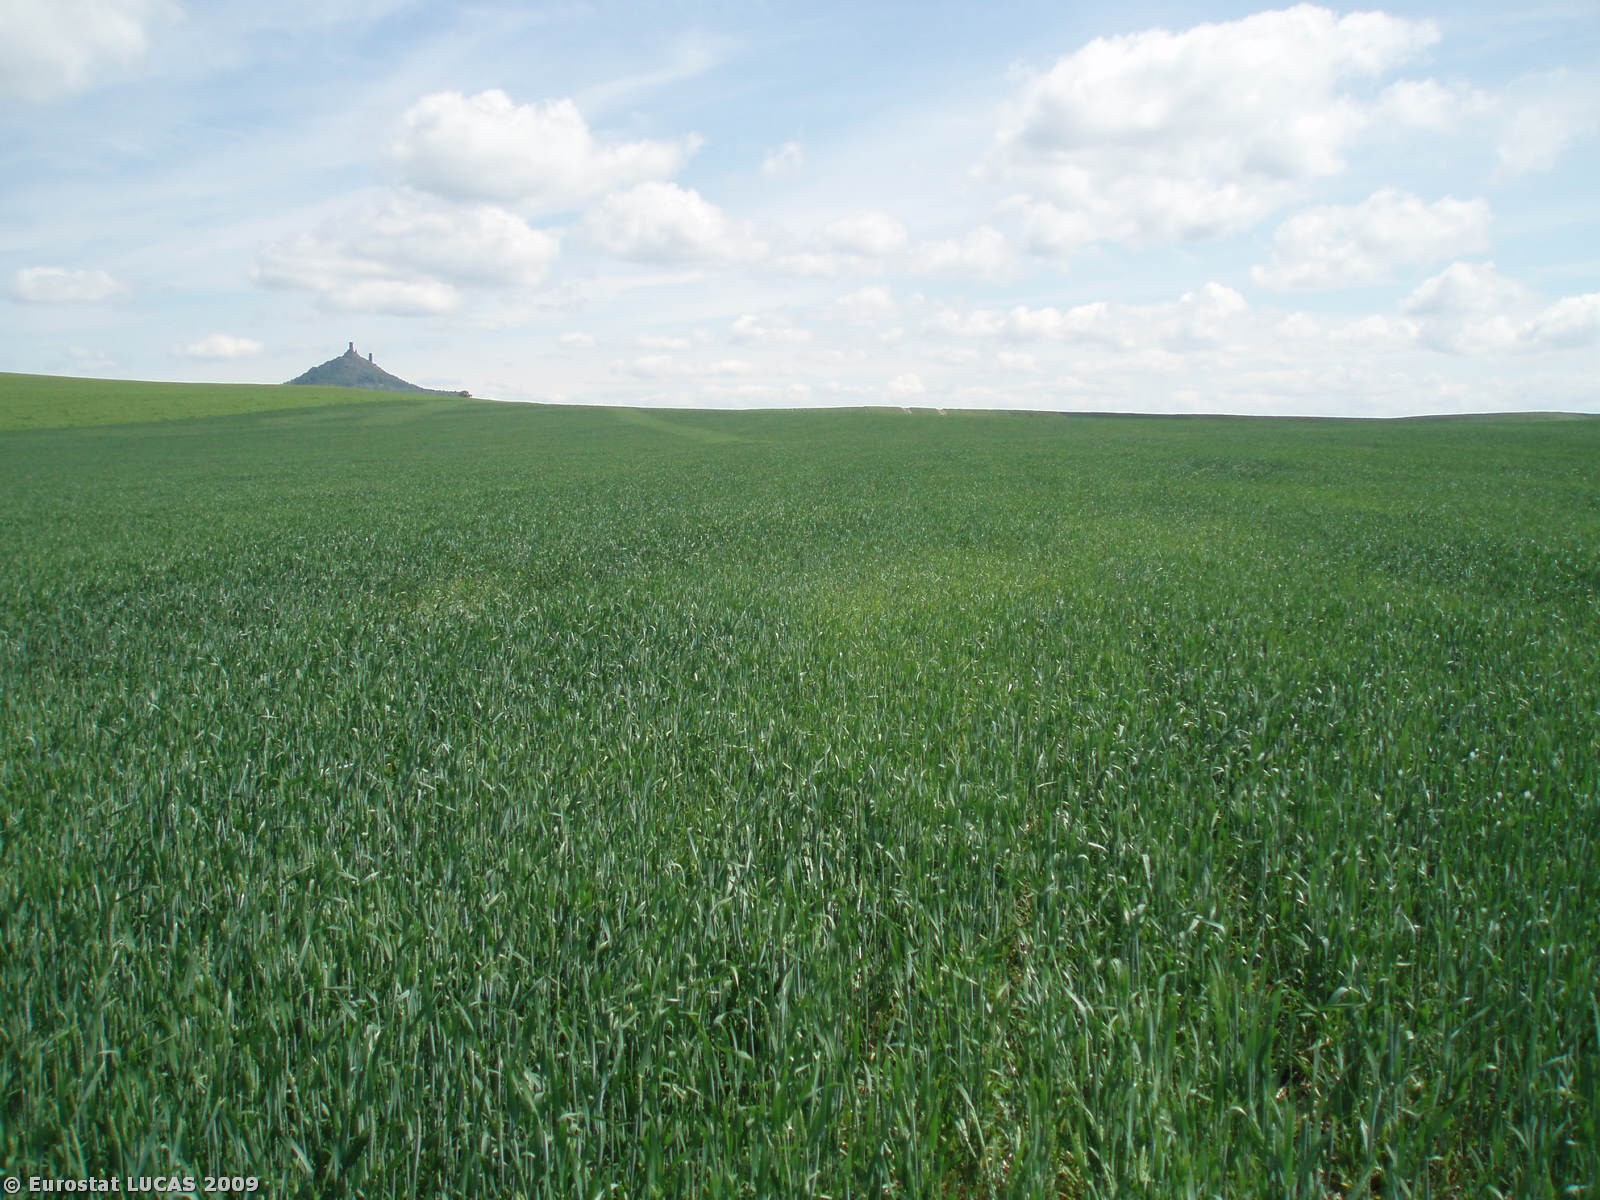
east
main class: Cropland
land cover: Common wheat
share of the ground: > 75 %
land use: Agriculture (excluding fallow land and kitchen gardens)
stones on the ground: < 10 %
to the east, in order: Common wheat
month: June
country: CZ
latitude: 50.4217
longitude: 13.9560
